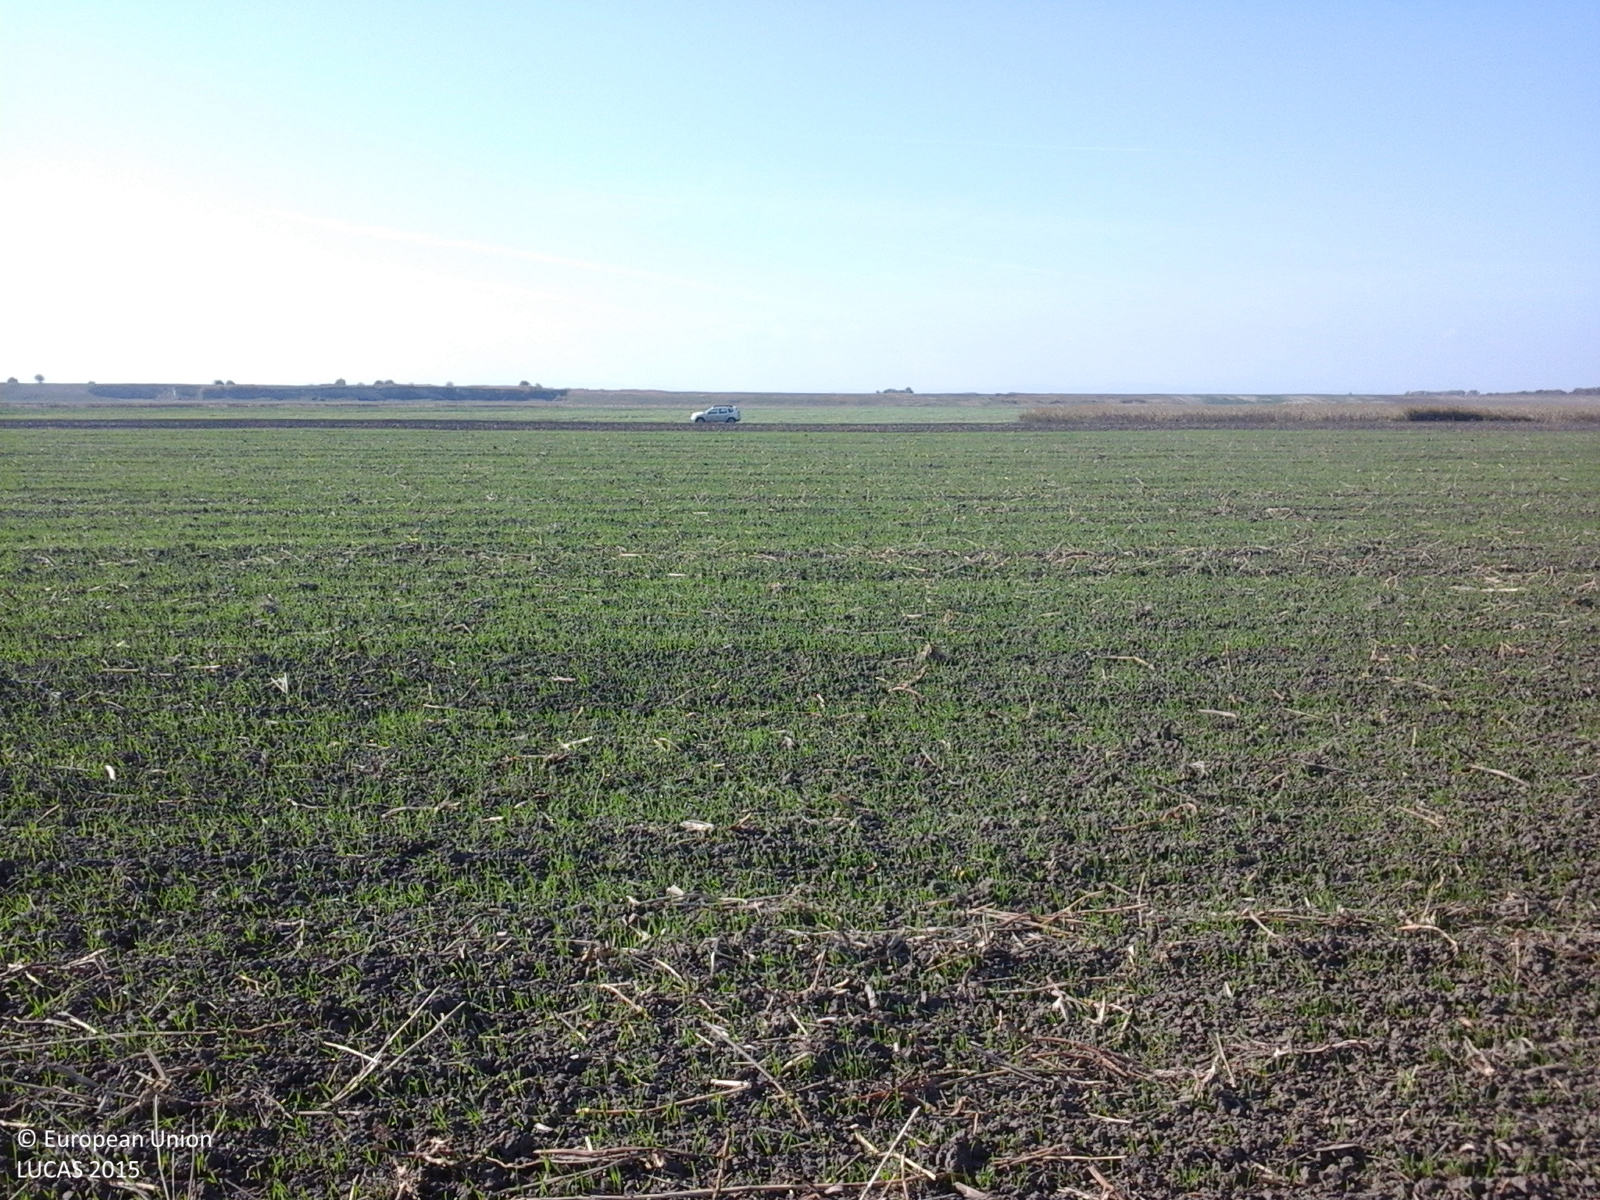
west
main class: Cropland
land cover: Common wheat
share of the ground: 25 - 50 %
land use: Agriculture (excluding fallow land and kitchen gardens)
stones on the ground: < 10 %
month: October
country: RO
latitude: 45.4145
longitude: 27.3610
